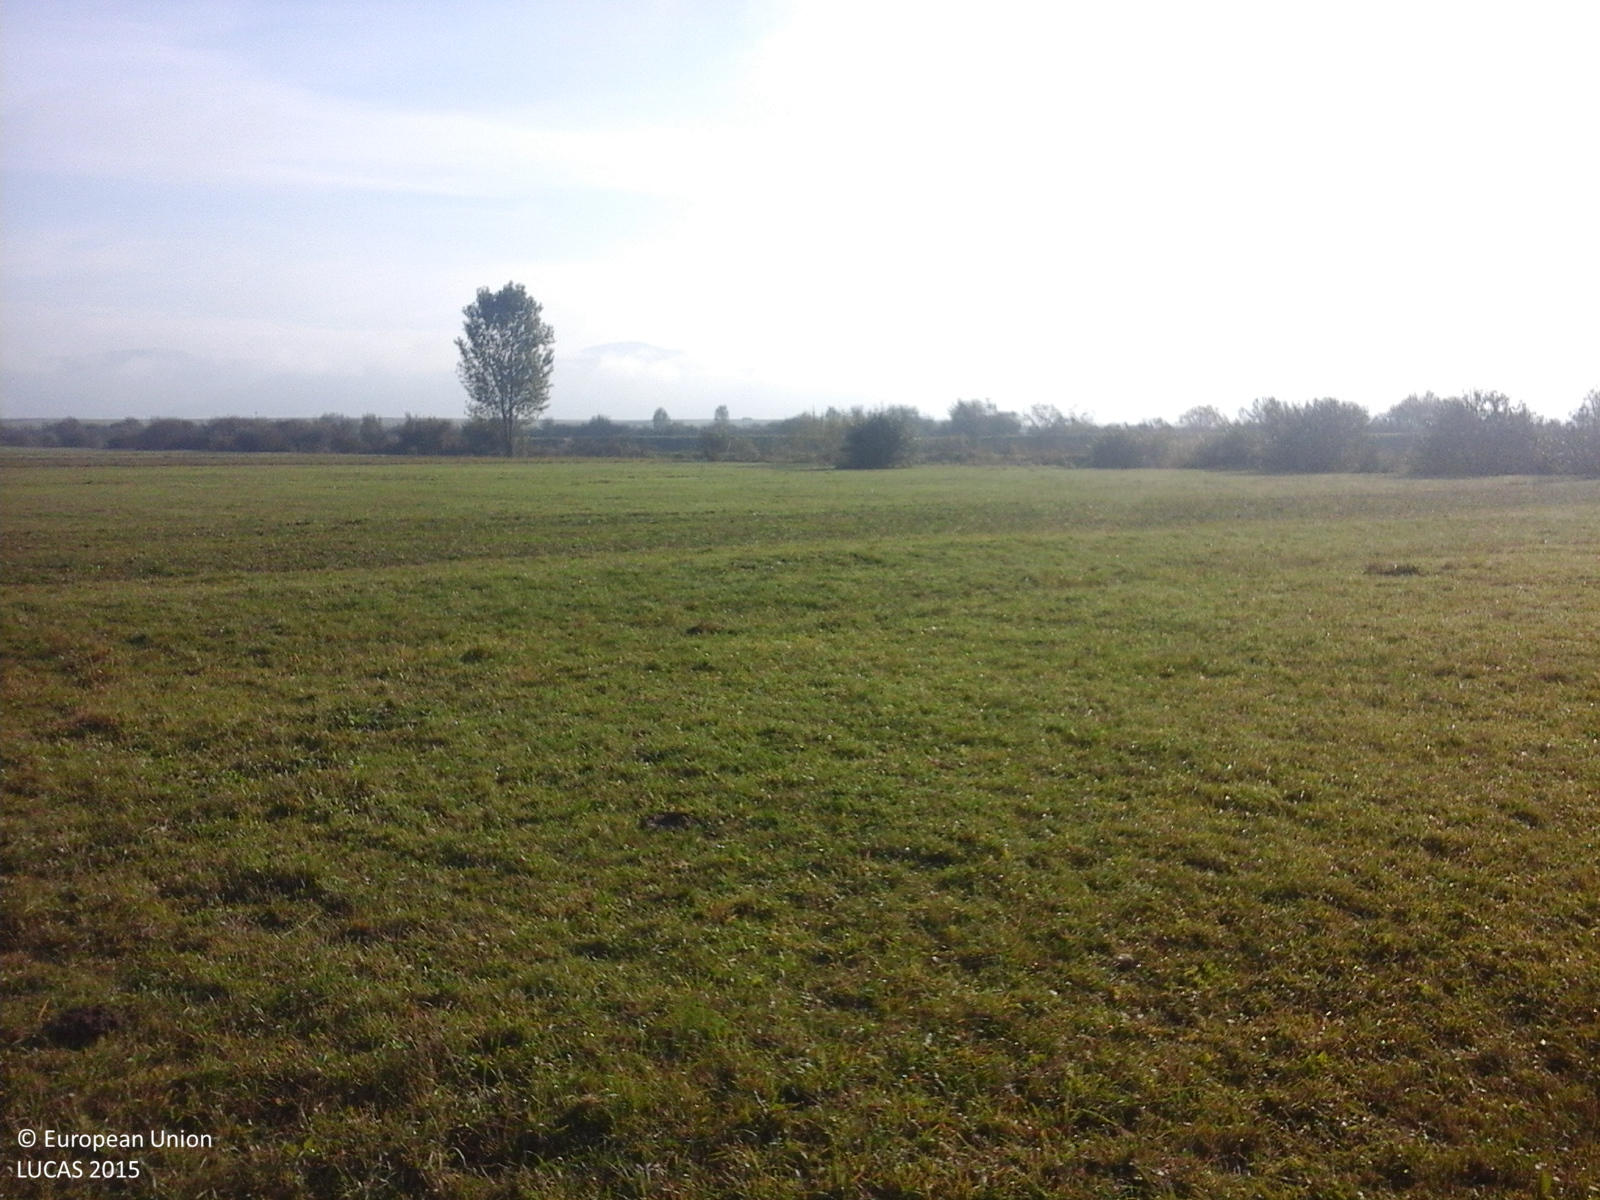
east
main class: Grassland
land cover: Grassland without tree/shrub cover
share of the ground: > 75 %
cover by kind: herbaceous plants 100 %
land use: Agriculture (excluding fallow land and kitchen gardens)
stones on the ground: < 10 %
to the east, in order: Grassland without tree/shrub cover; Ditches and canals; Spontaneously vegetated surfaces; Tracks; Grassland without tree/shrub cover; Abandoned hedges; Ditches and canals; Abandoned hedges; Grassland without tree/shrub cover
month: October
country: RO
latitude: 46.2348
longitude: 25.8977
